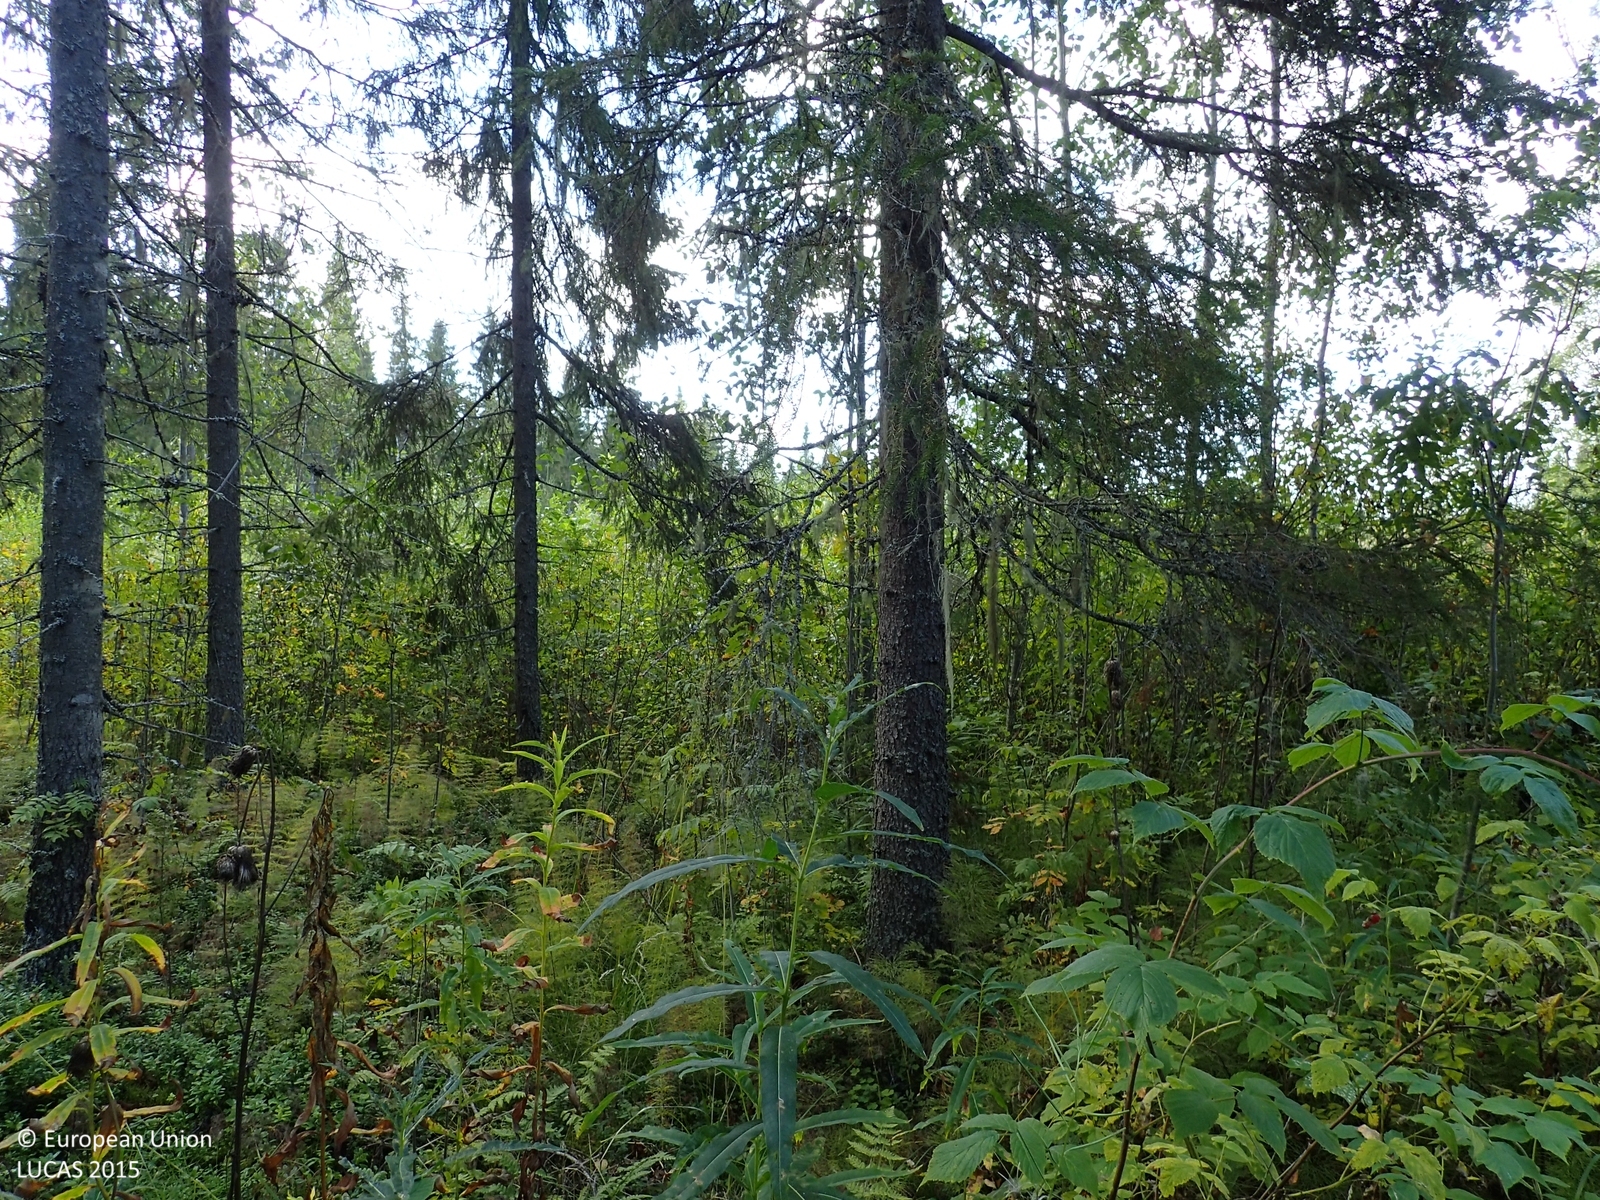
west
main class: Woodland
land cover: Spruce dominated coniferous woodland
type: boreal forest
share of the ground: > 75 %
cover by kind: coniferous forest trees 70 %, herbaceous plants 20 %, broadleaved forest trees 5 %, shrubs 5 %
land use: Forestry
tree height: > 5 m
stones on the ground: < 10 %
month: September
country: FI
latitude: 63.1859
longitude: 25.5042
